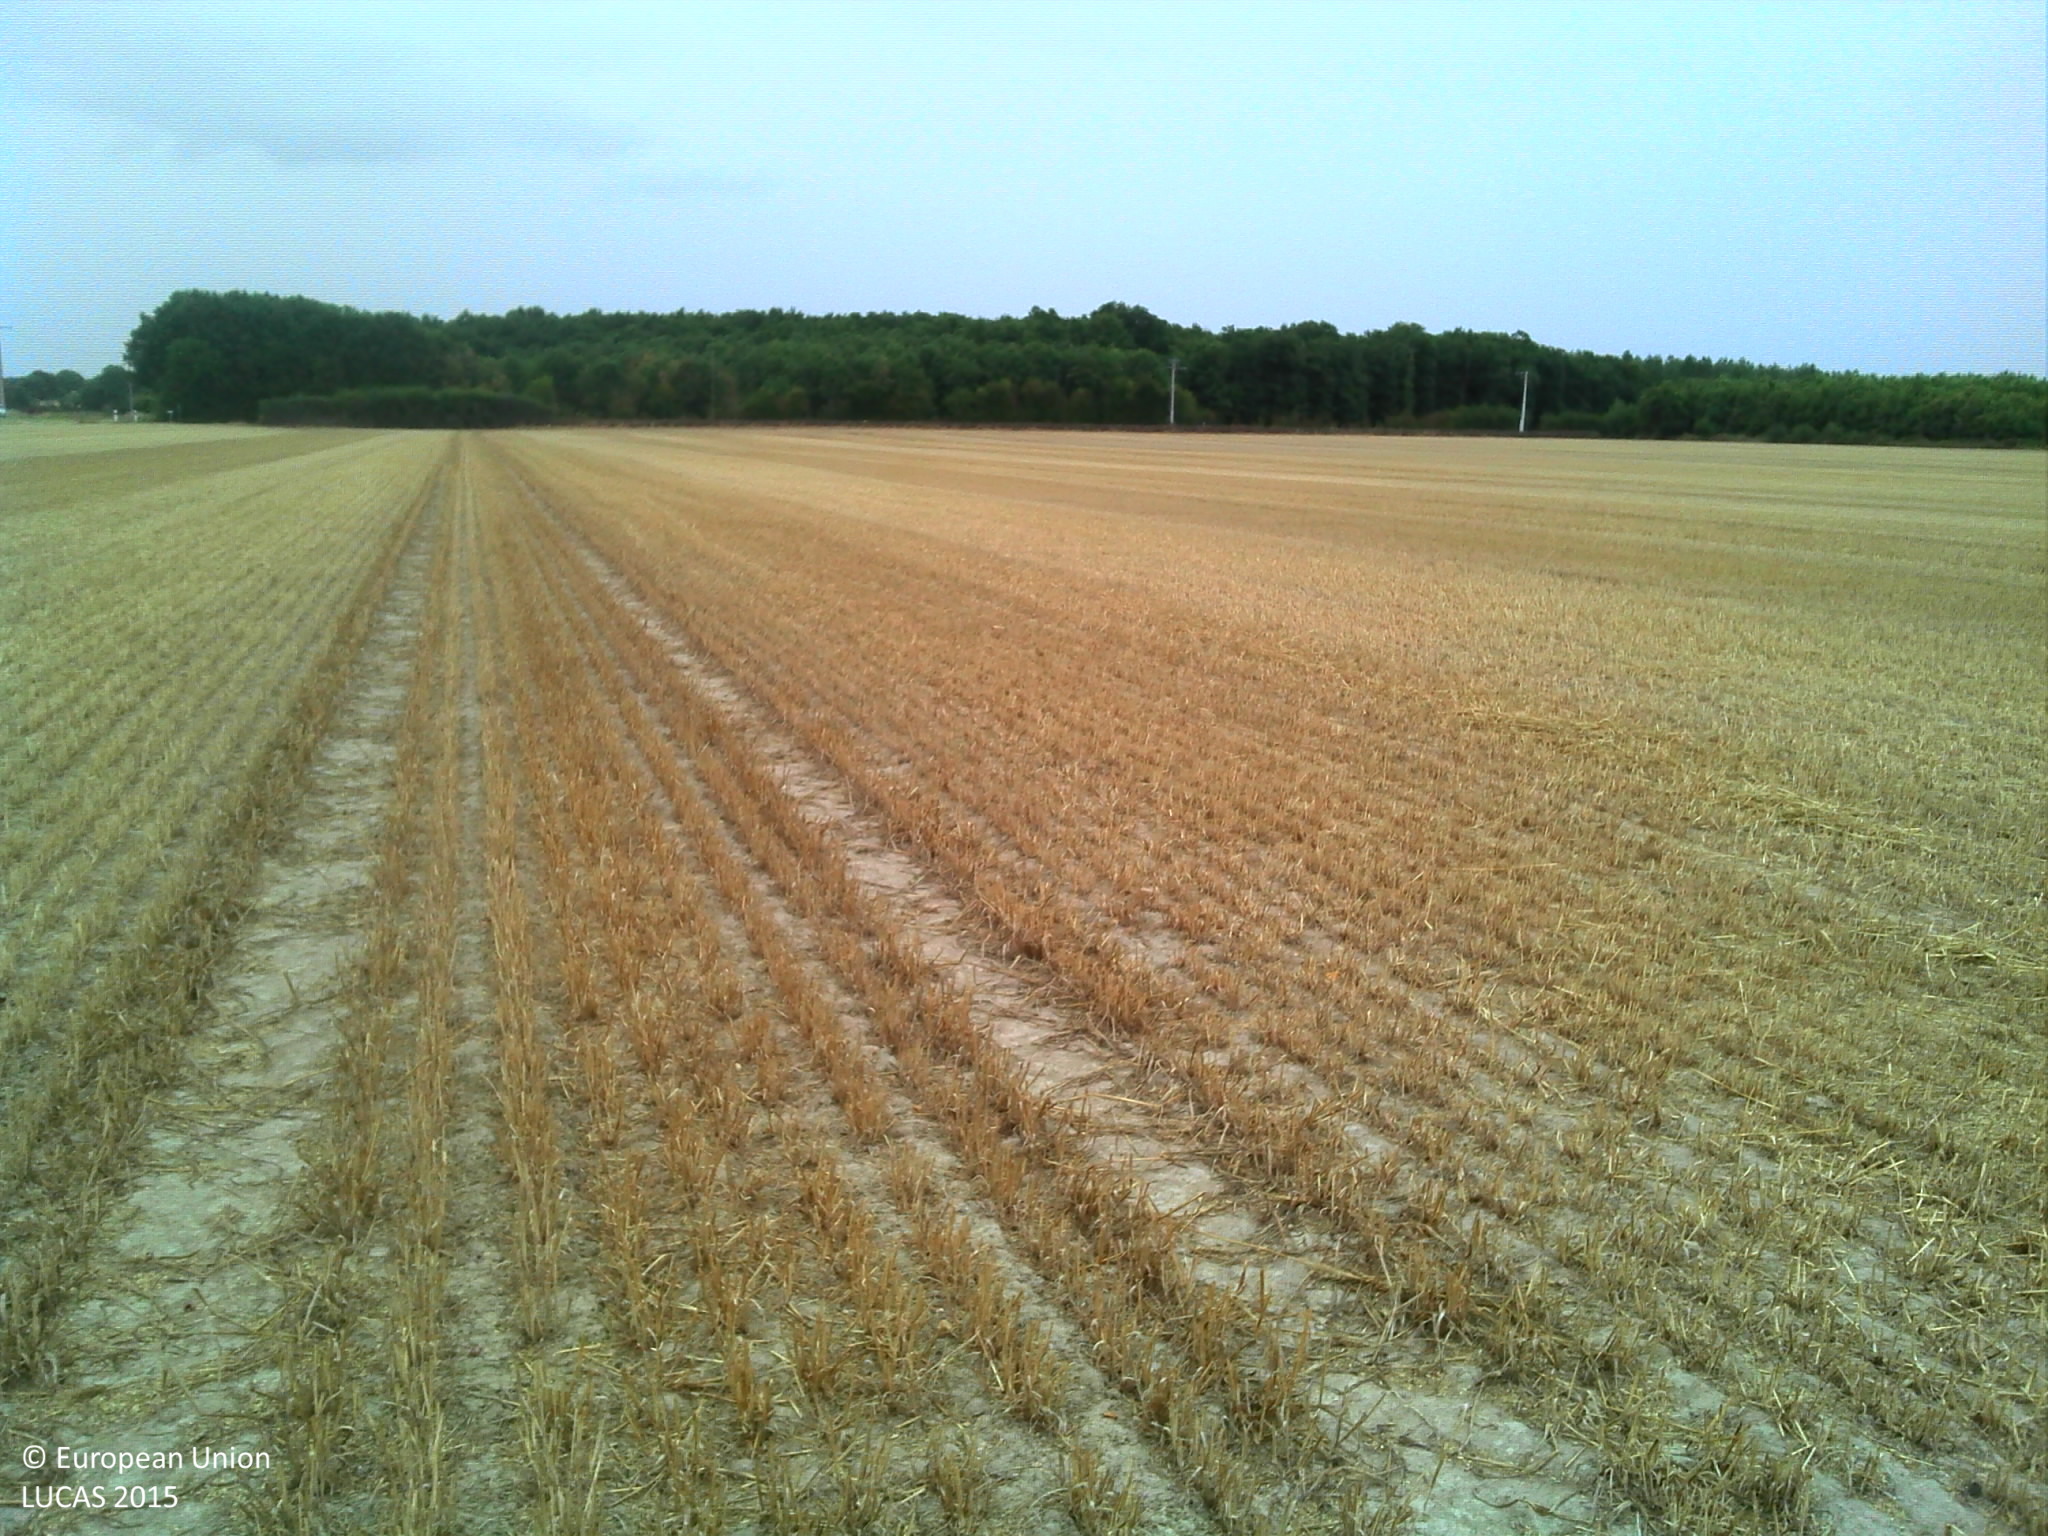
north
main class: Cropland
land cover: Common wheat
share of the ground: > 75 %
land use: Agriculture (excluding fallow land and kitchen gardens)
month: July
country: FR
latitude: 46.7858
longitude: 2.1461
